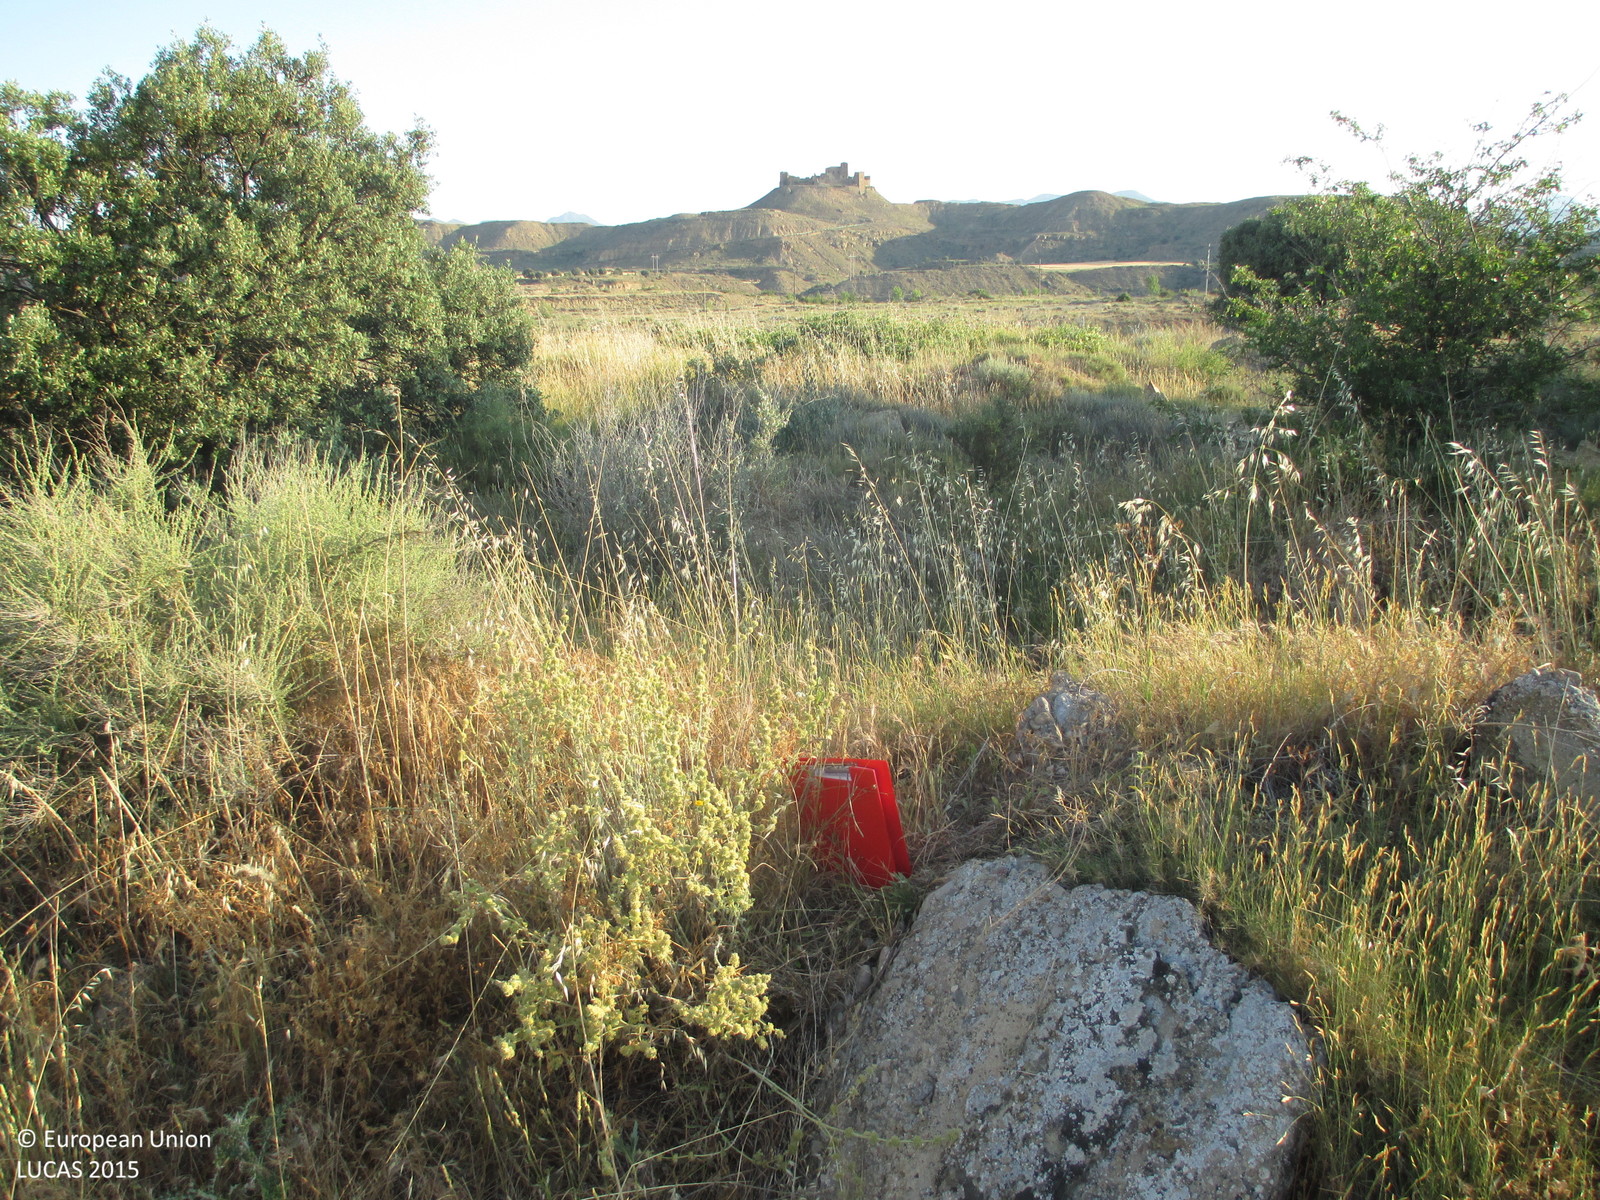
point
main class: Grassland
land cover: Grassland with sparse tree/shrub cover
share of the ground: > 75 %
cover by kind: herbaceous plants 90 %, broadleaved forest trees 5 %, shrubs 5 %
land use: Semi-natural and natural areas not in use
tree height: < 5 m
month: June
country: ES
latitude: 42.1413
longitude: -0.3431
